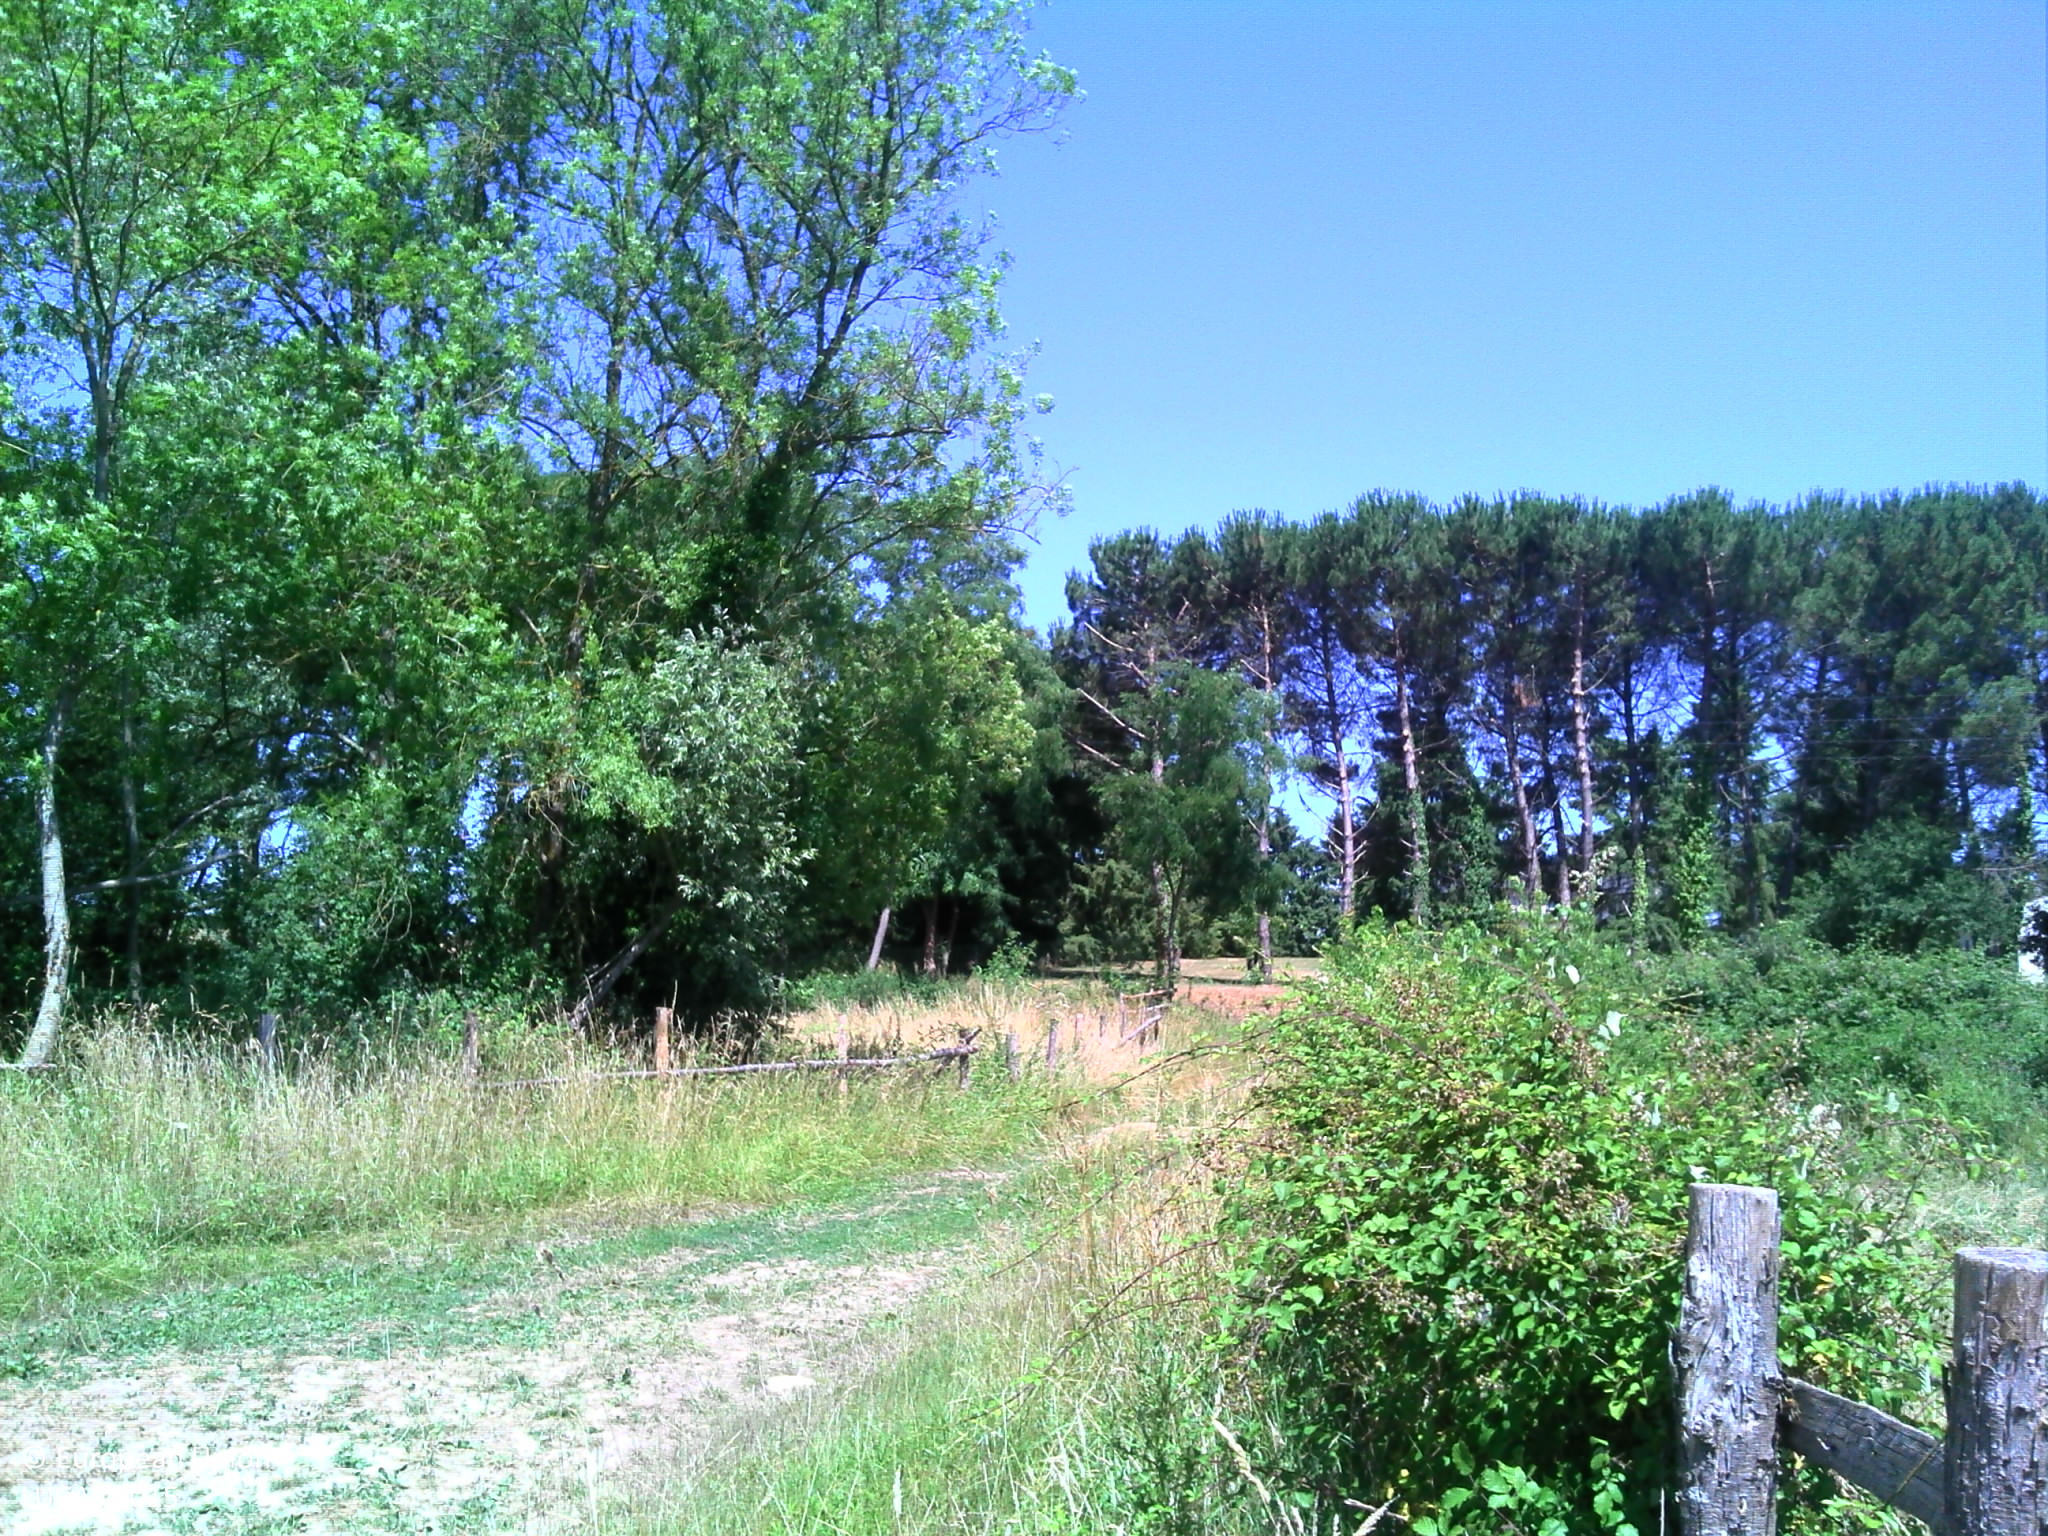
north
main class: Grassland
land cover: Grassland without tree/shrub cover
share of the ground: > 75 %
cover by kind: herbaceous plants 95 %, shrubs 5 %
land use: Agriculture (excluding fallow land and kitchen gardens)
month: July
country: FR
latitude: 47.6675
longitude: 0.2943
